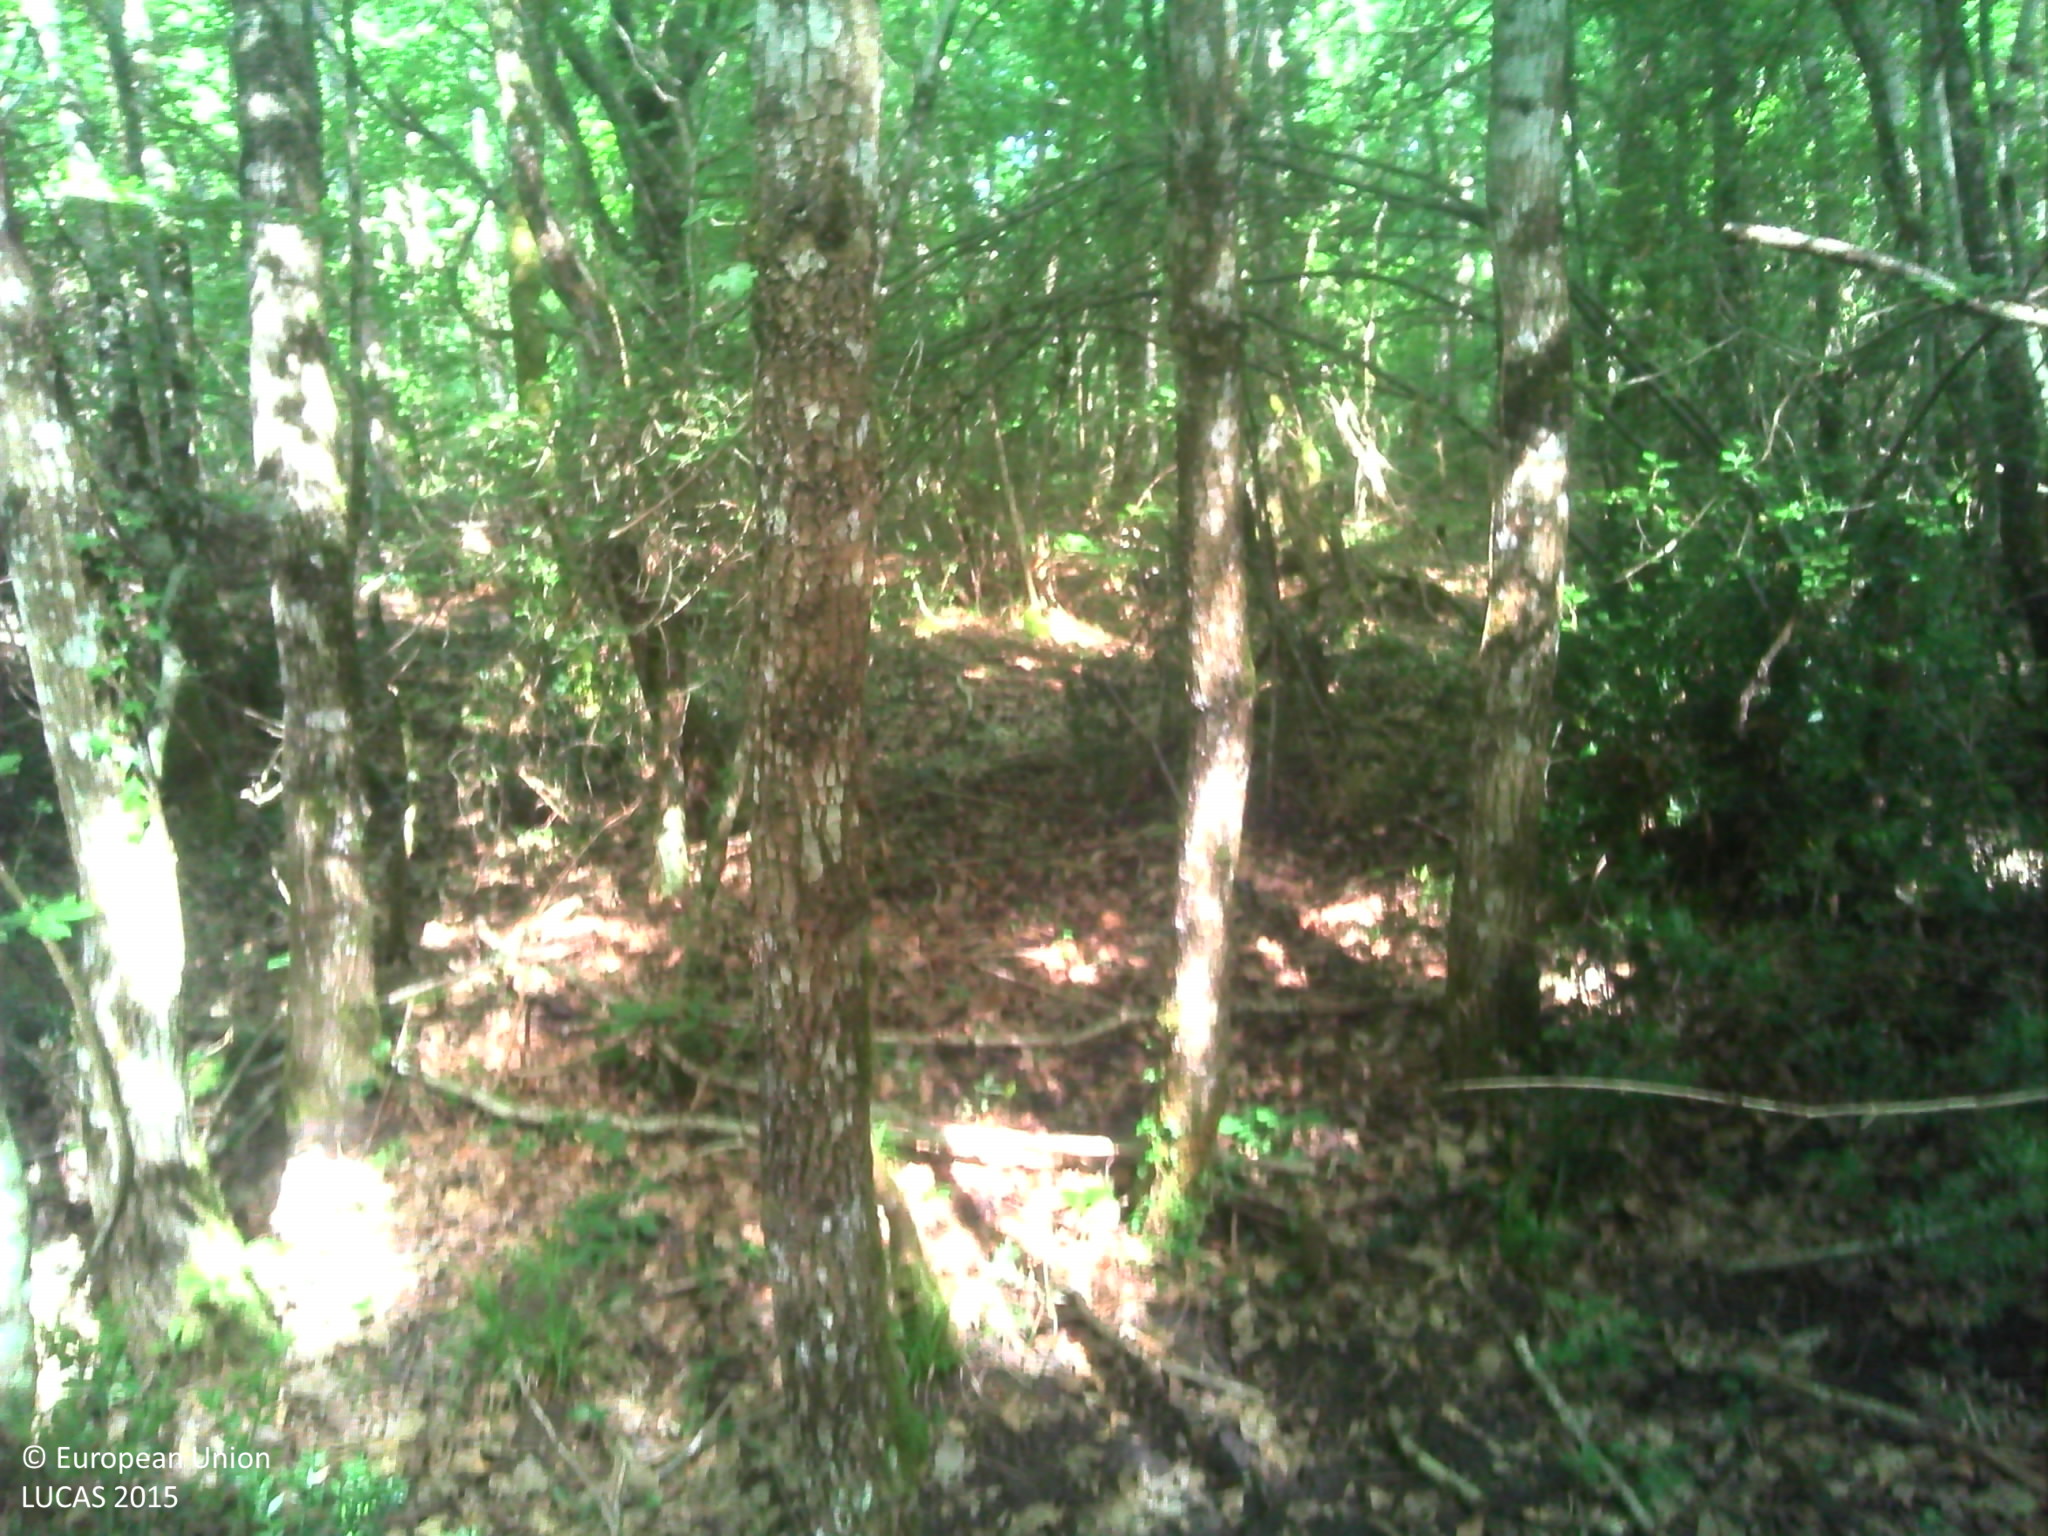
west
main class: Woodland
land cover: Broadleaved woodland
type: mesophytic deciduous forest
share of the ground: > 75 %
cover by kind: unconsolidated bare surface 50 %, herbaceous plants 30 %, broadleaved forest trees 20 %
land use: Forestry
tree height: > 5 m
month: June
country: FR
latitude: 47.5224
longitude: 1.3659
